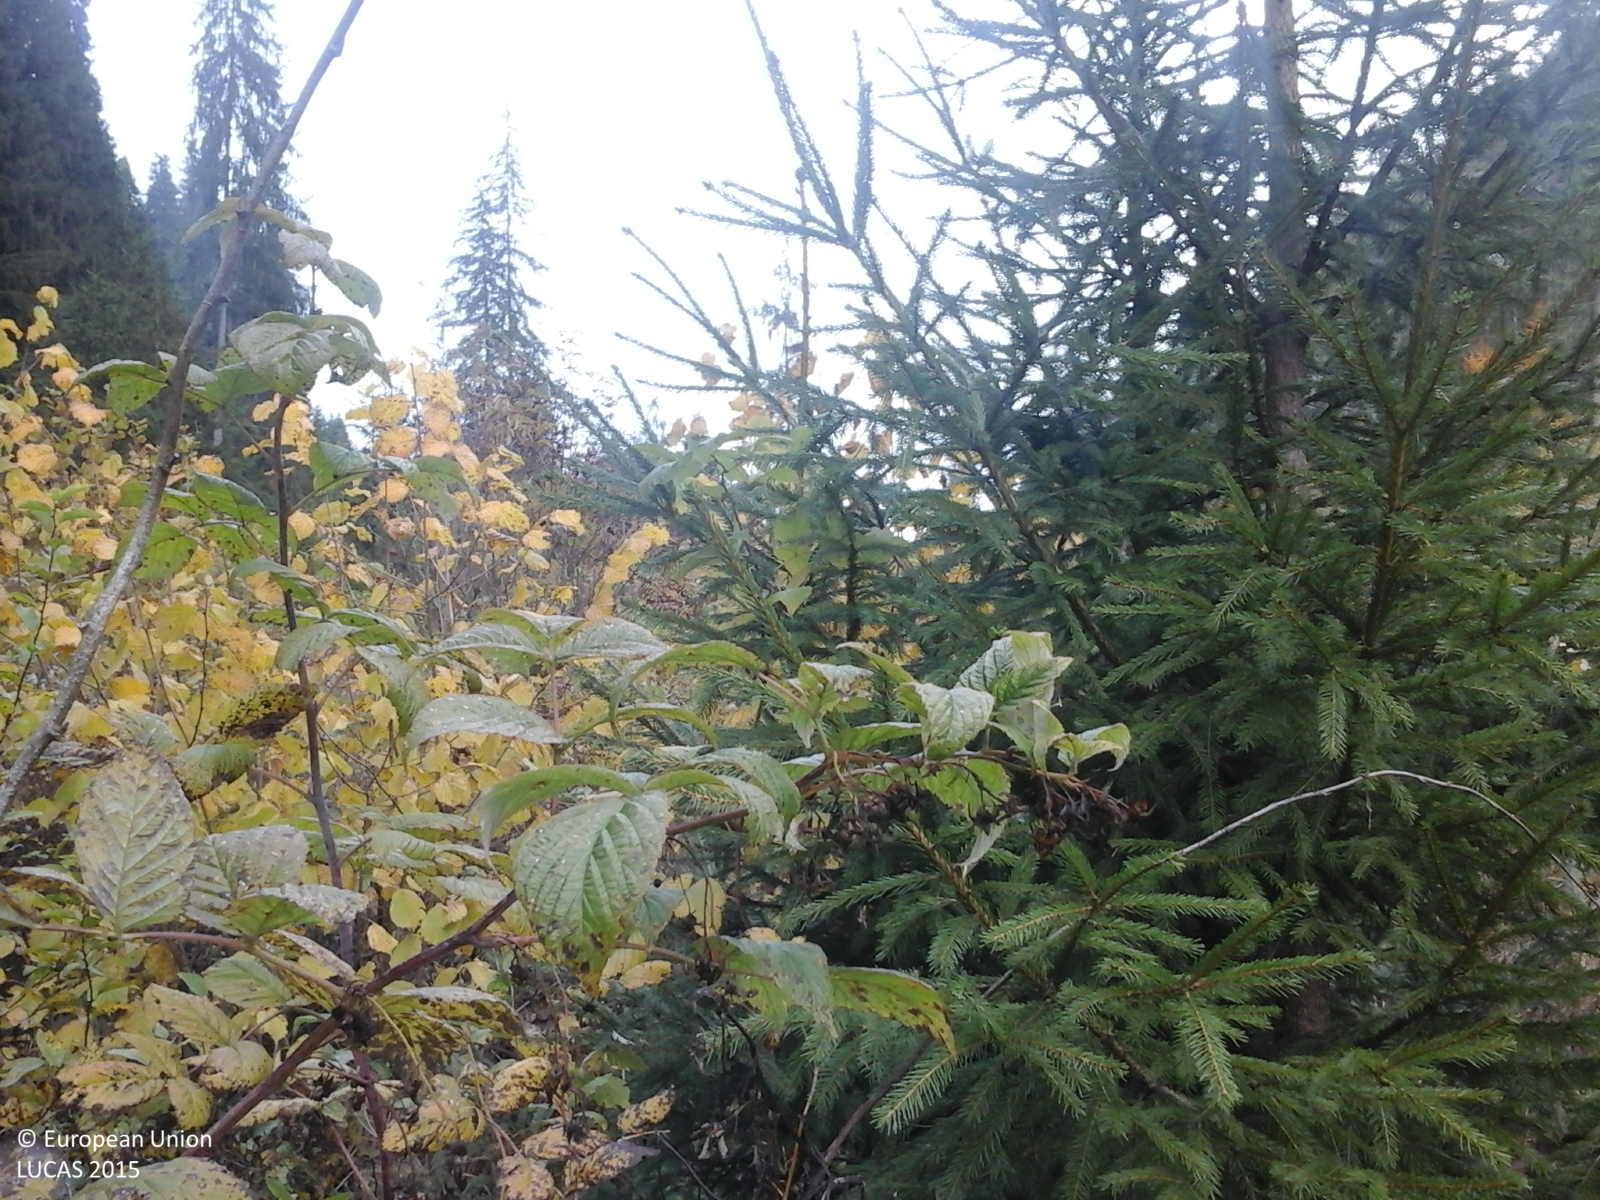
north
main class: Shrubland
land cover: Shrubland with sparse tree cover
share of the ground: > 75 %
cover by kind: shrubs 95 %, broadleaved forest trees 5 %
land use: Semi-natural and natural areas not in use
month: October
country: RO
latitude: 46.5184
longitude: 25.3428
